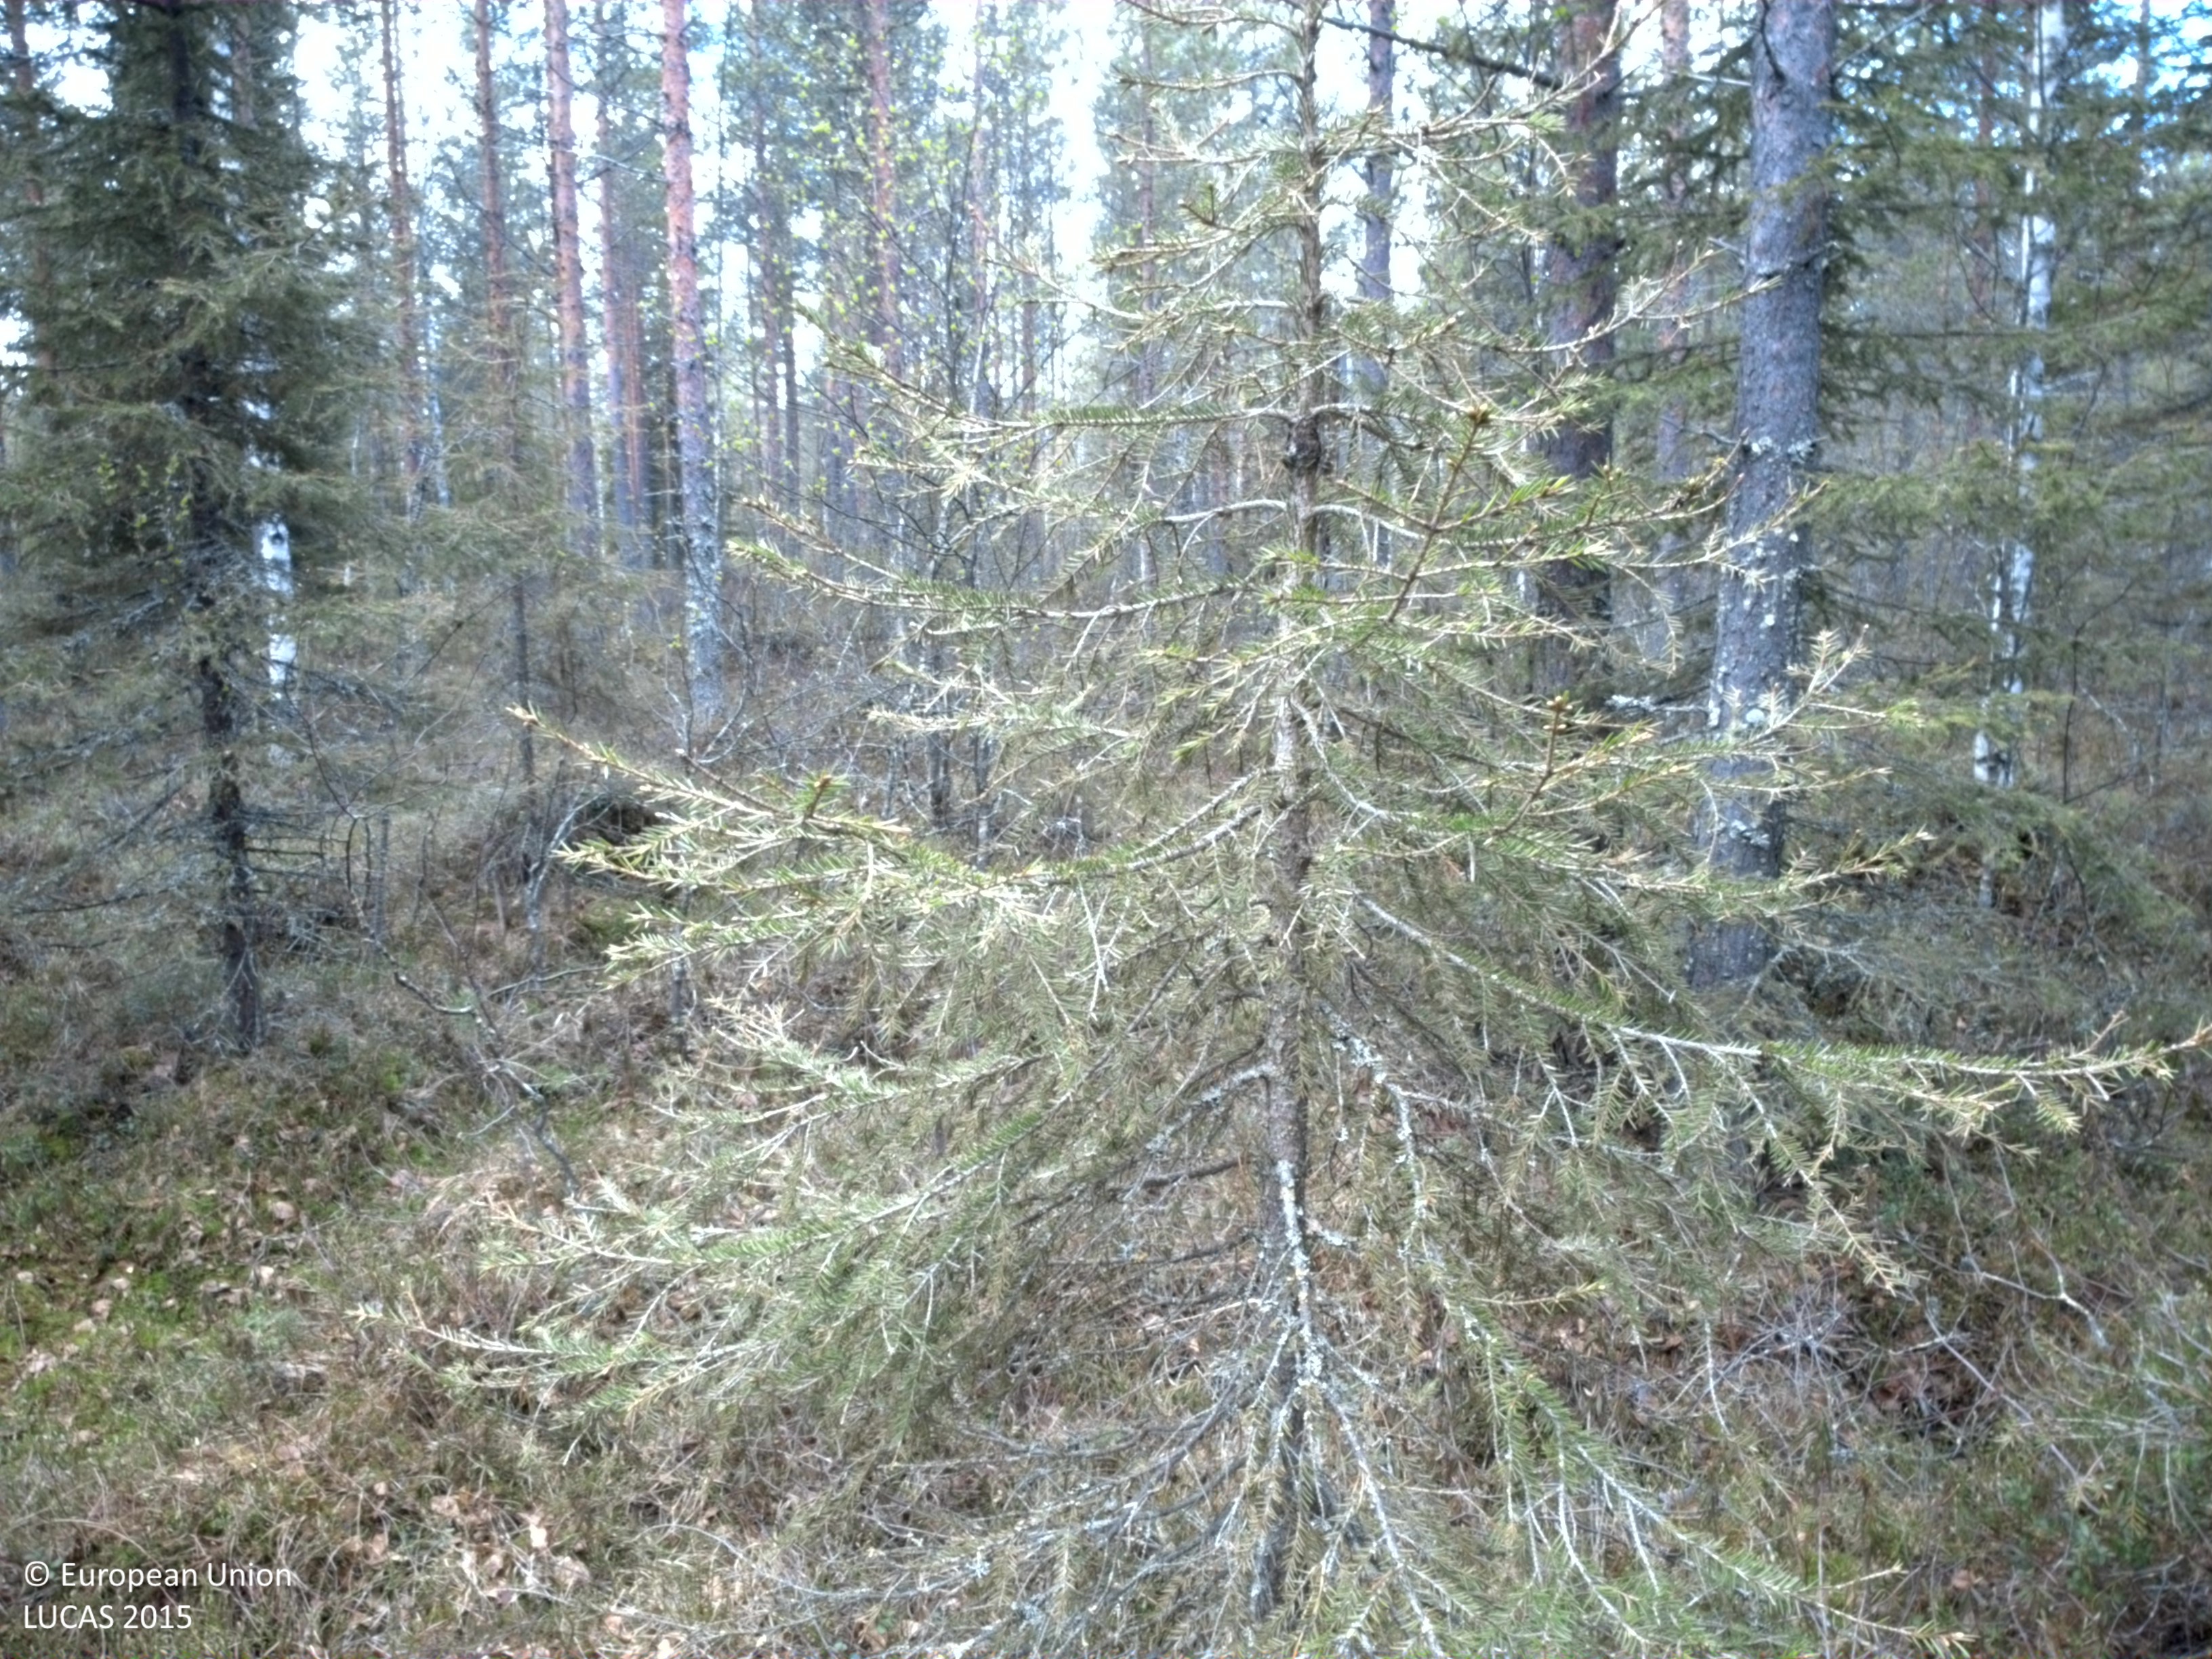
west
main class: Woodland
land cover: Pine dominated mixed woodland
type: boreal forest
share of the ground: > 75 %
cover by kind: coniferous forest trees 60 %, broadleaved forest trees 20 %, shrubs 20 %
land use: Forestry
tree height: > 5 m
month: May
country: SE
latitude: 66.0987
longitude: 23.2800
